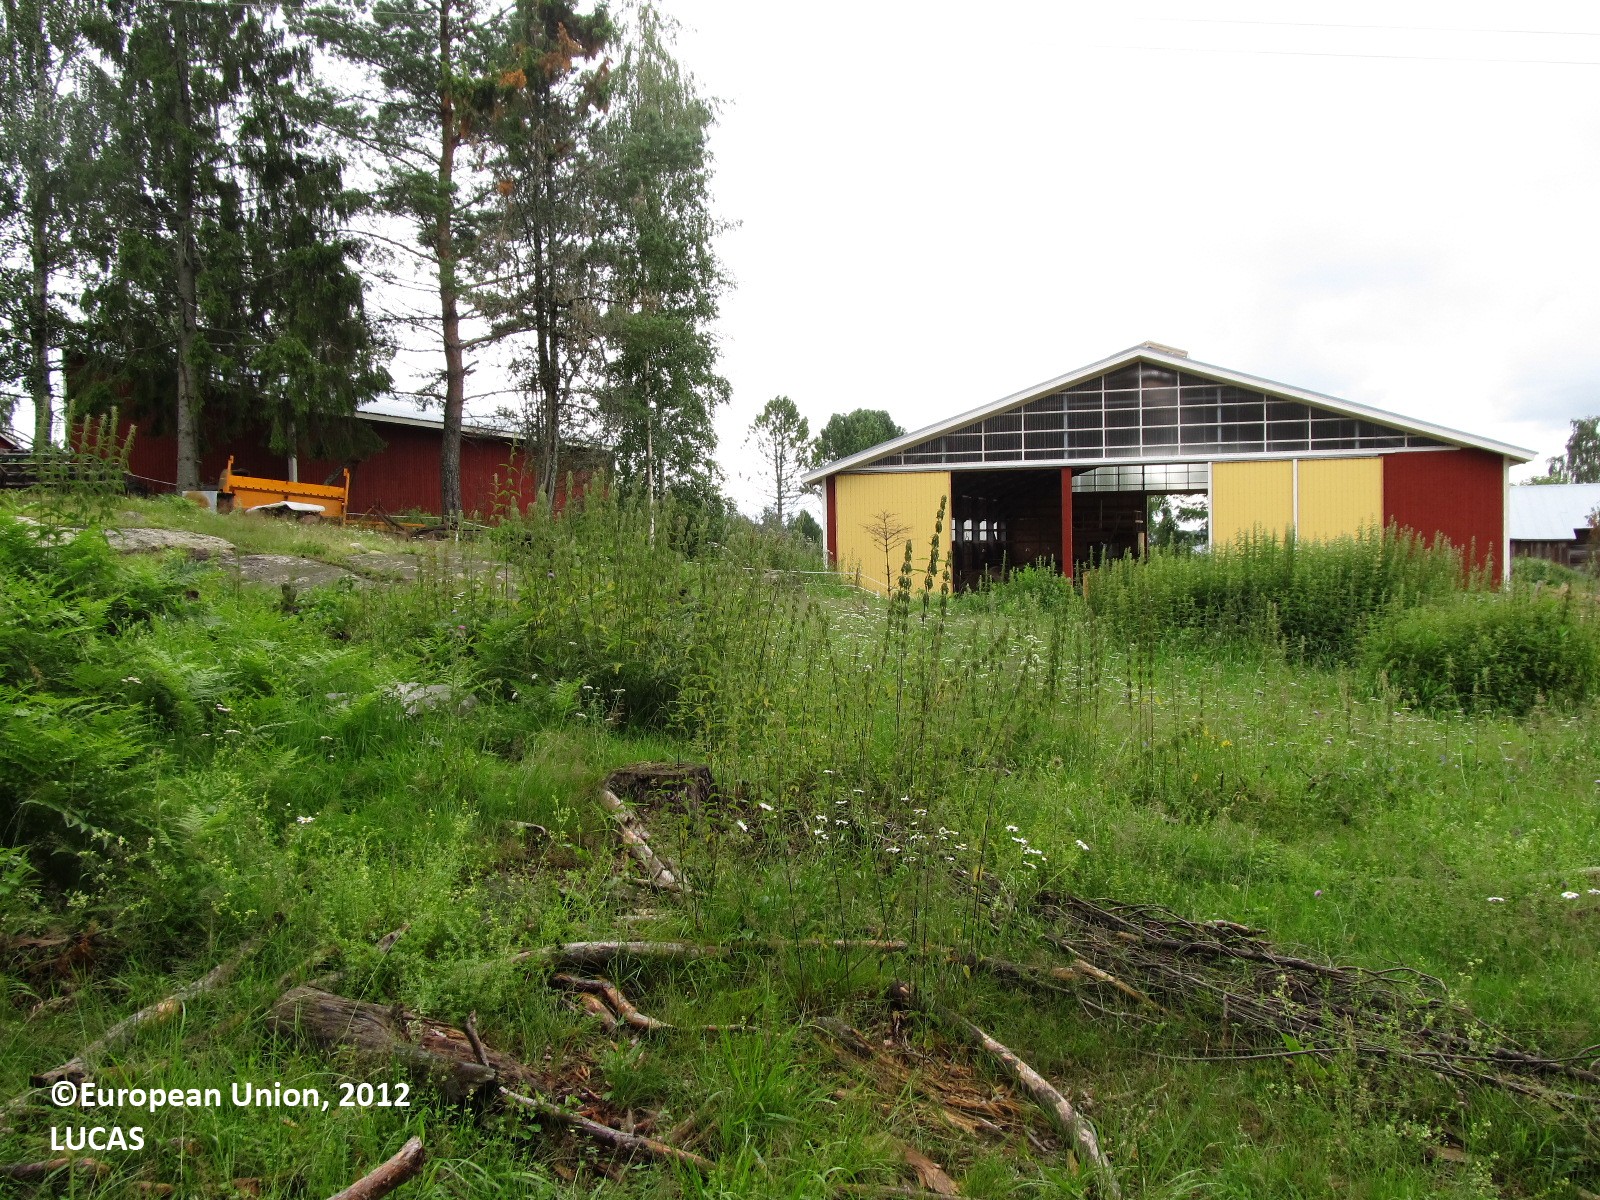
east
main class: Grassland
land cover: Grassland without tree/shrub cover
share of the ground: 25 - 50 %
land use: Forestry
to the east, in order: Grassland without tree/shrub cover; Rocks and stones; Tracks; Artificial constructions in urban areas; Fences; Temporary grasslands; Fences; Spruce dominated coniferous woodland
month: July
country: FI
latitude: 61.8472
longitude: 29.0175
